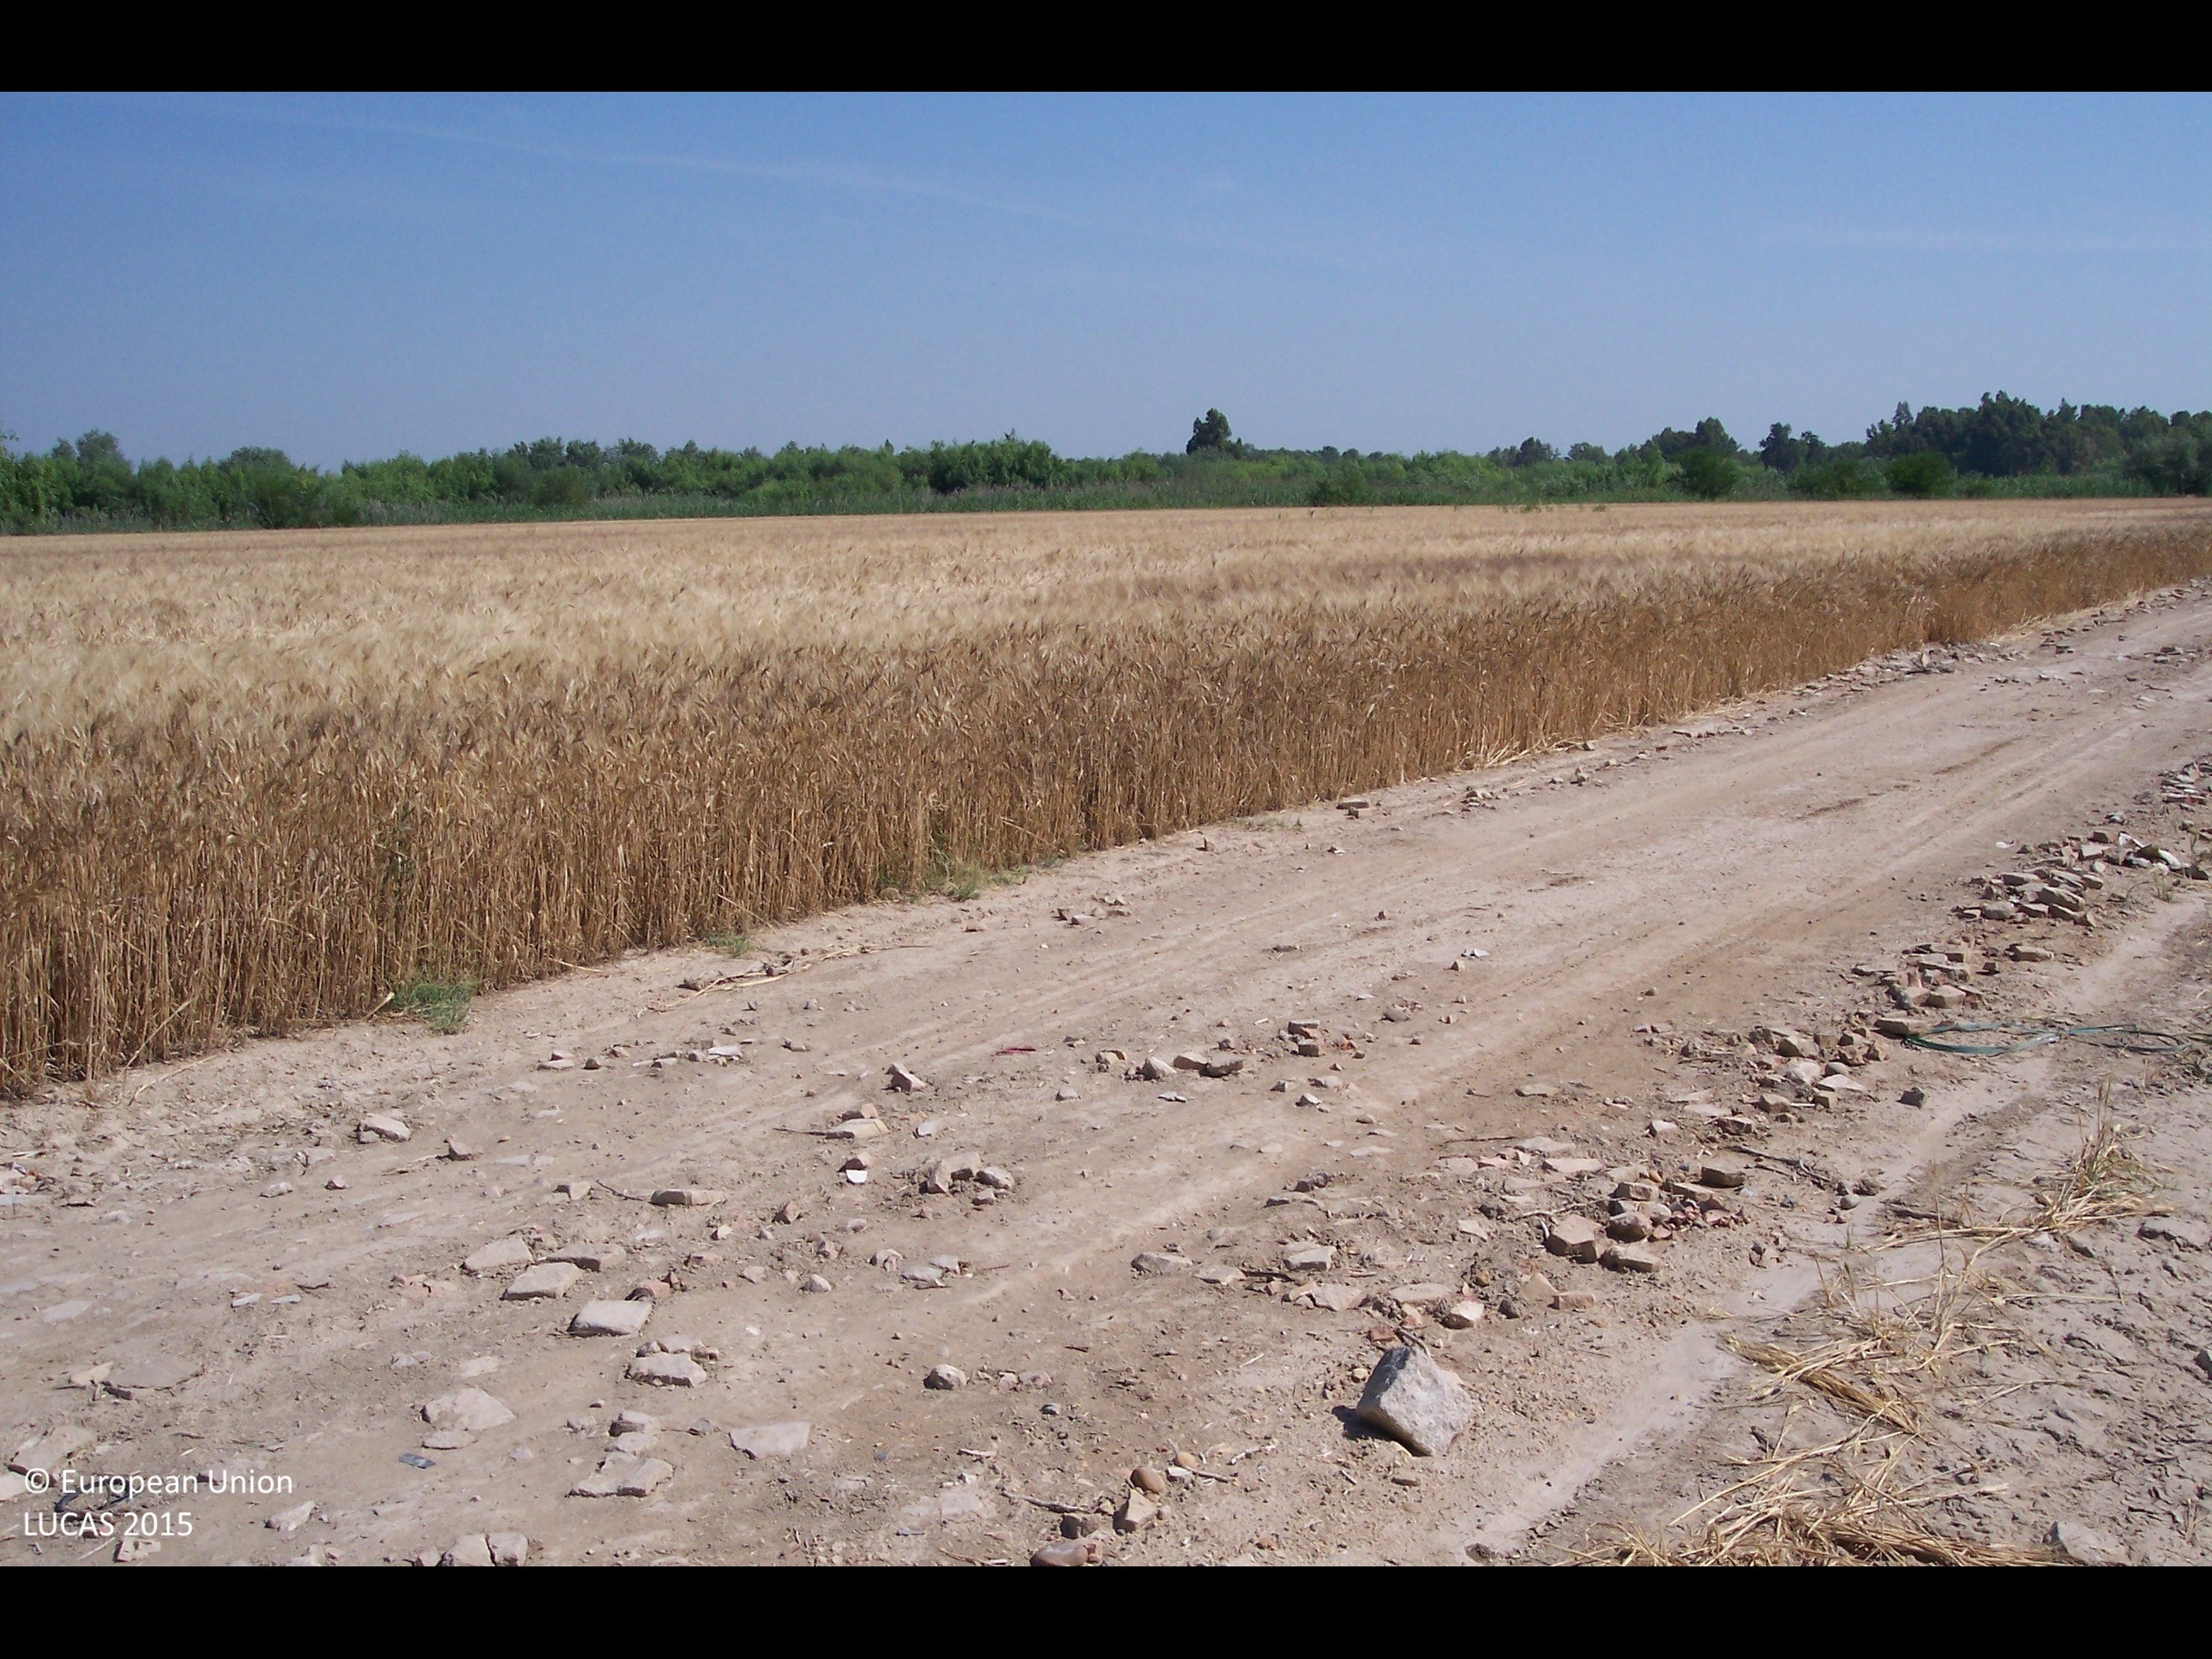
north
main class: Cropland
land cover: Durum wheat
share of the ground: > 75 %
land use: Agriculture (excluding fallow land and kitchen gardens)
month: May
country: ES
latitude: 37.2215
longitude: -6.0585
